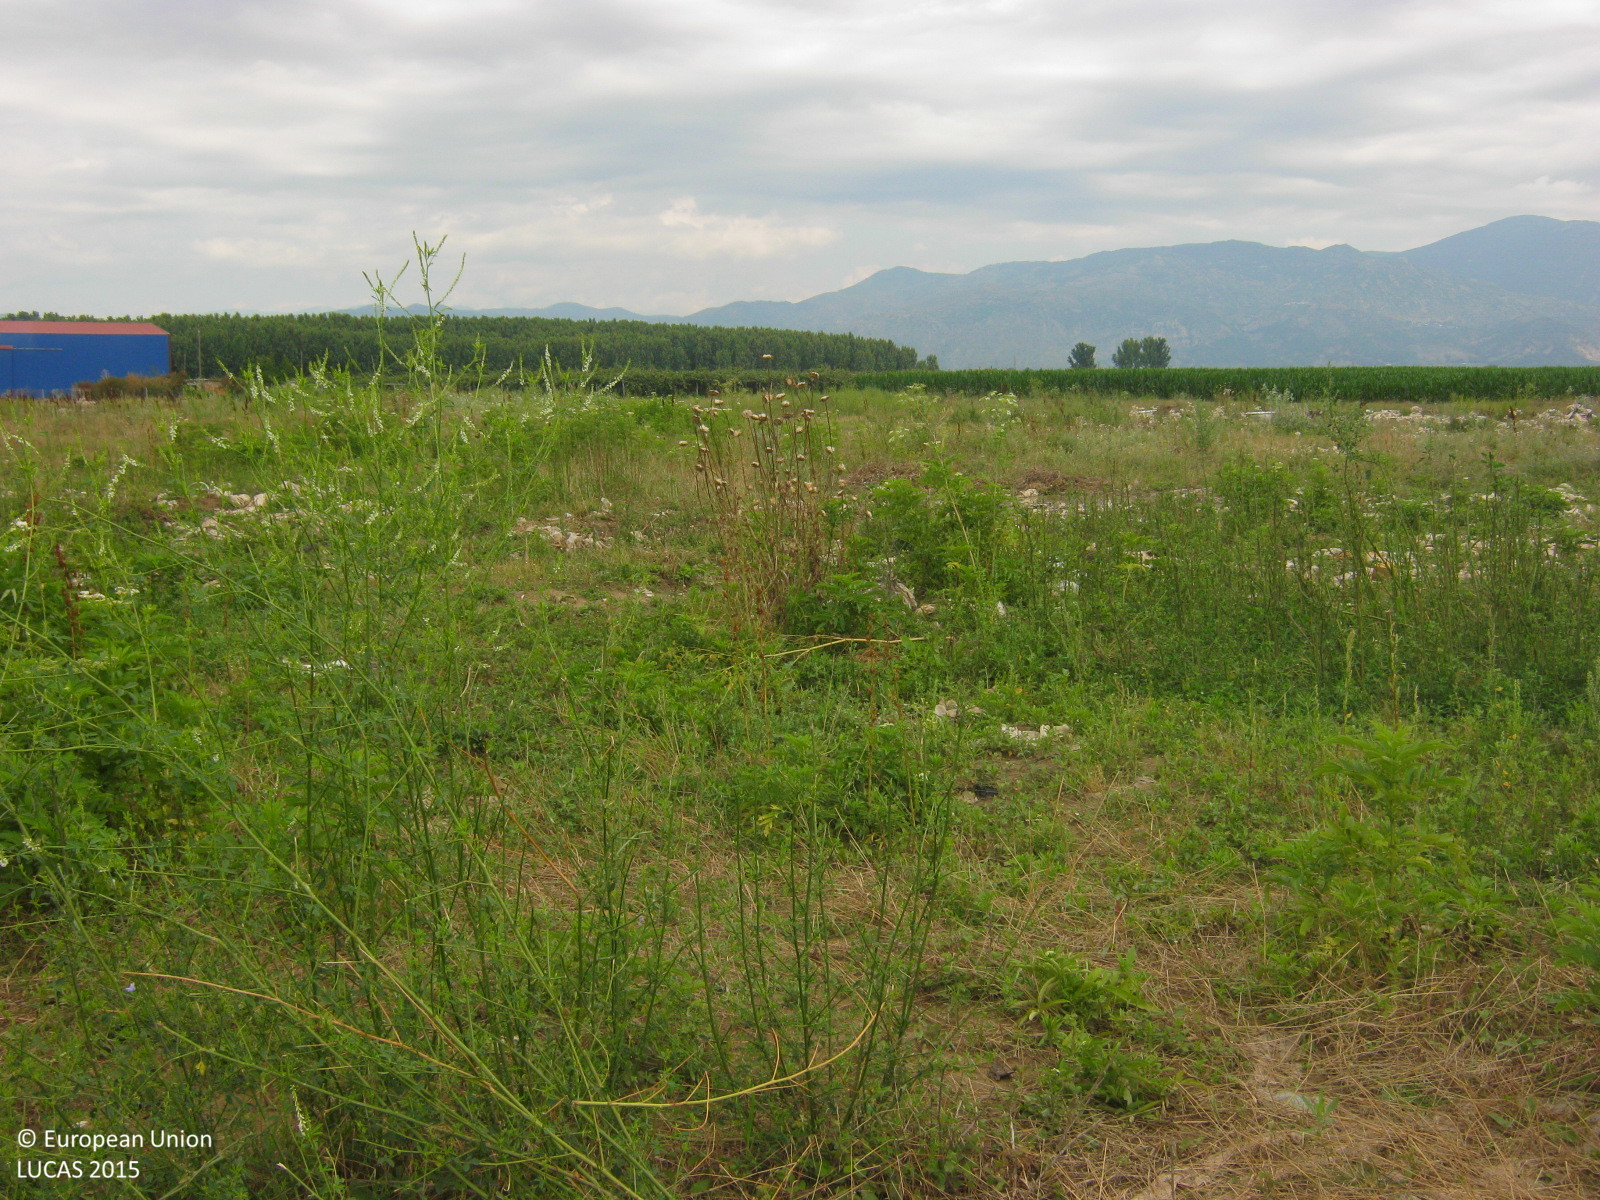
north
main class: Grassland
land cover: Spontaneously vegetated surfaces
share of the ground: > 75 %
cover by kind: herbaceous plants 100 %
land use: Abandoned areas
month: June
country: GR
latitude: 41.0743
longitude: 24.9790
